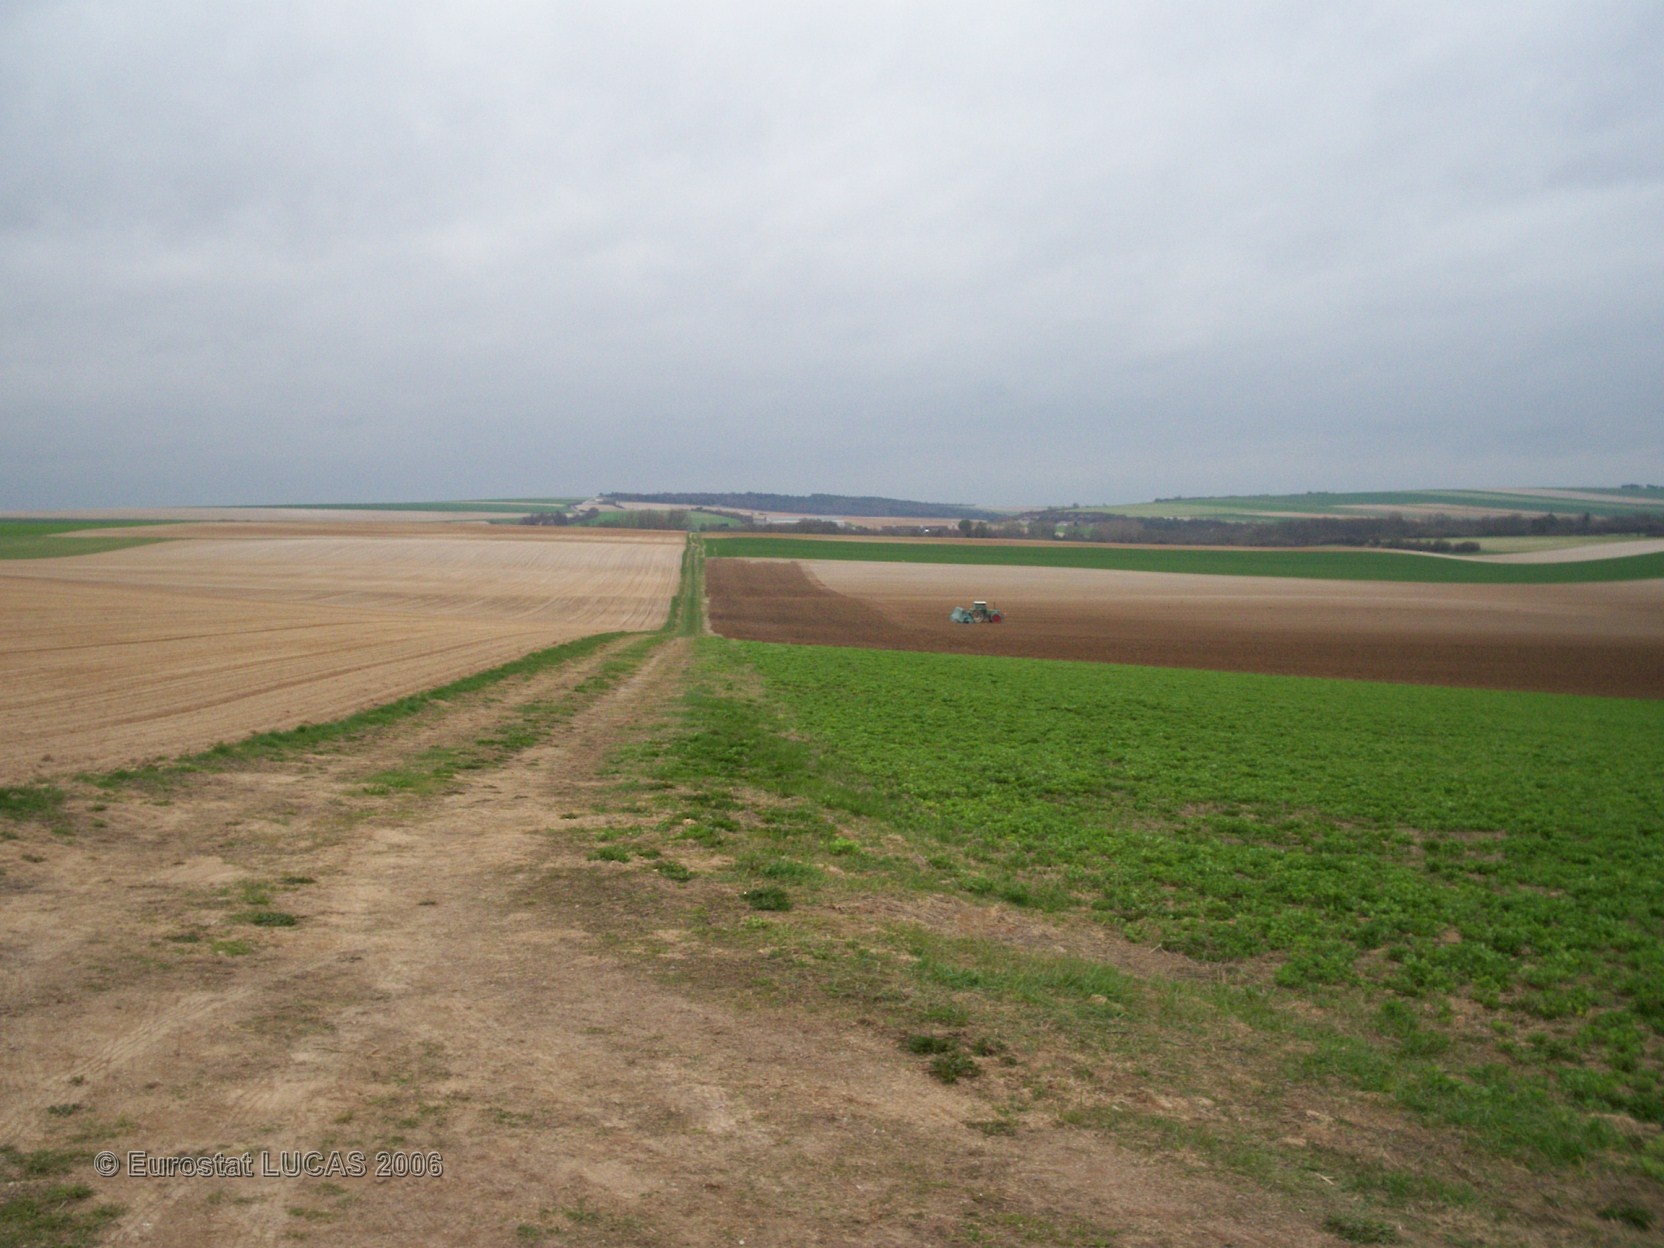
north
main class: Cropland
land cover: Rape and turnip rape
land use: Agriculture (excluding fallow land and kitchen gardens)
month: April
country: FR
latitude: 49.2205
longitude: 4.4633
